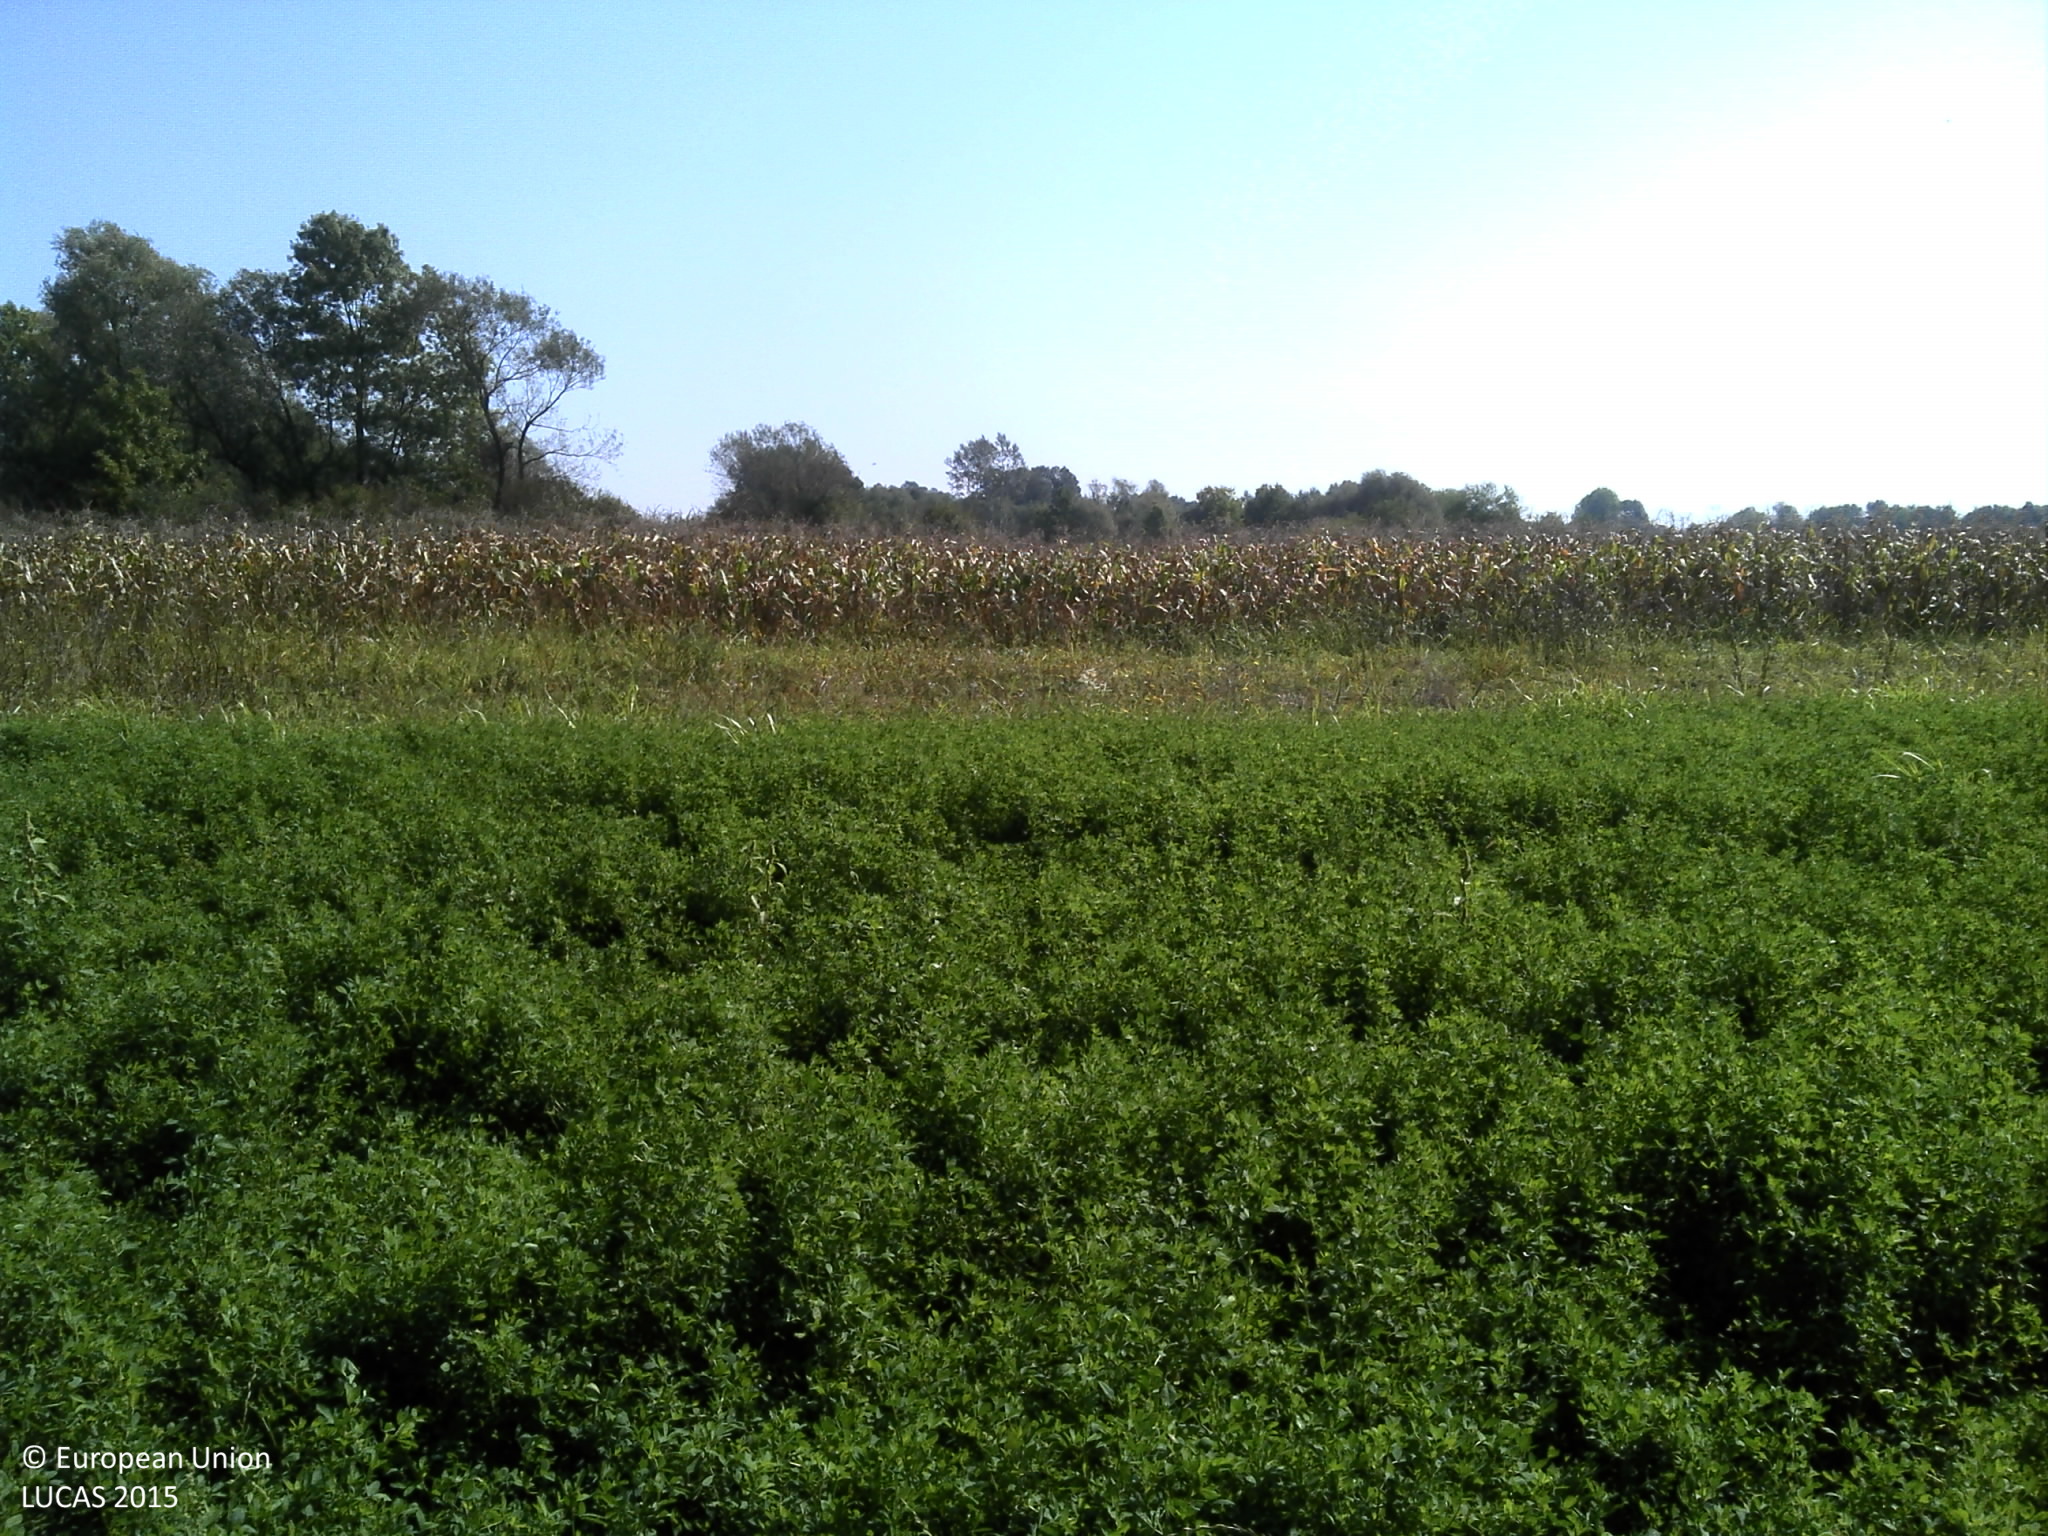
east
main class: Grassland
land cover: Grassland without tree/shrub cover
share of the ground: > 75 %
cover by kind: herbaceous plants 100 %
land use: Semi-natural and natural areas not in use
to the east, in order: Grassland without tree/shrub cover; Clovers; Spontaneously vegetated surfaces; Maize; Spontaneously vegetated surfaces; Maize; Shrubland without tree cover; Grassland without tree/shrub cover; Shrubland with sparse tree cover; Grassland without tree/shrub cover
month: September
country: HR
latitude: 45.6401
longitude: 16.3231
